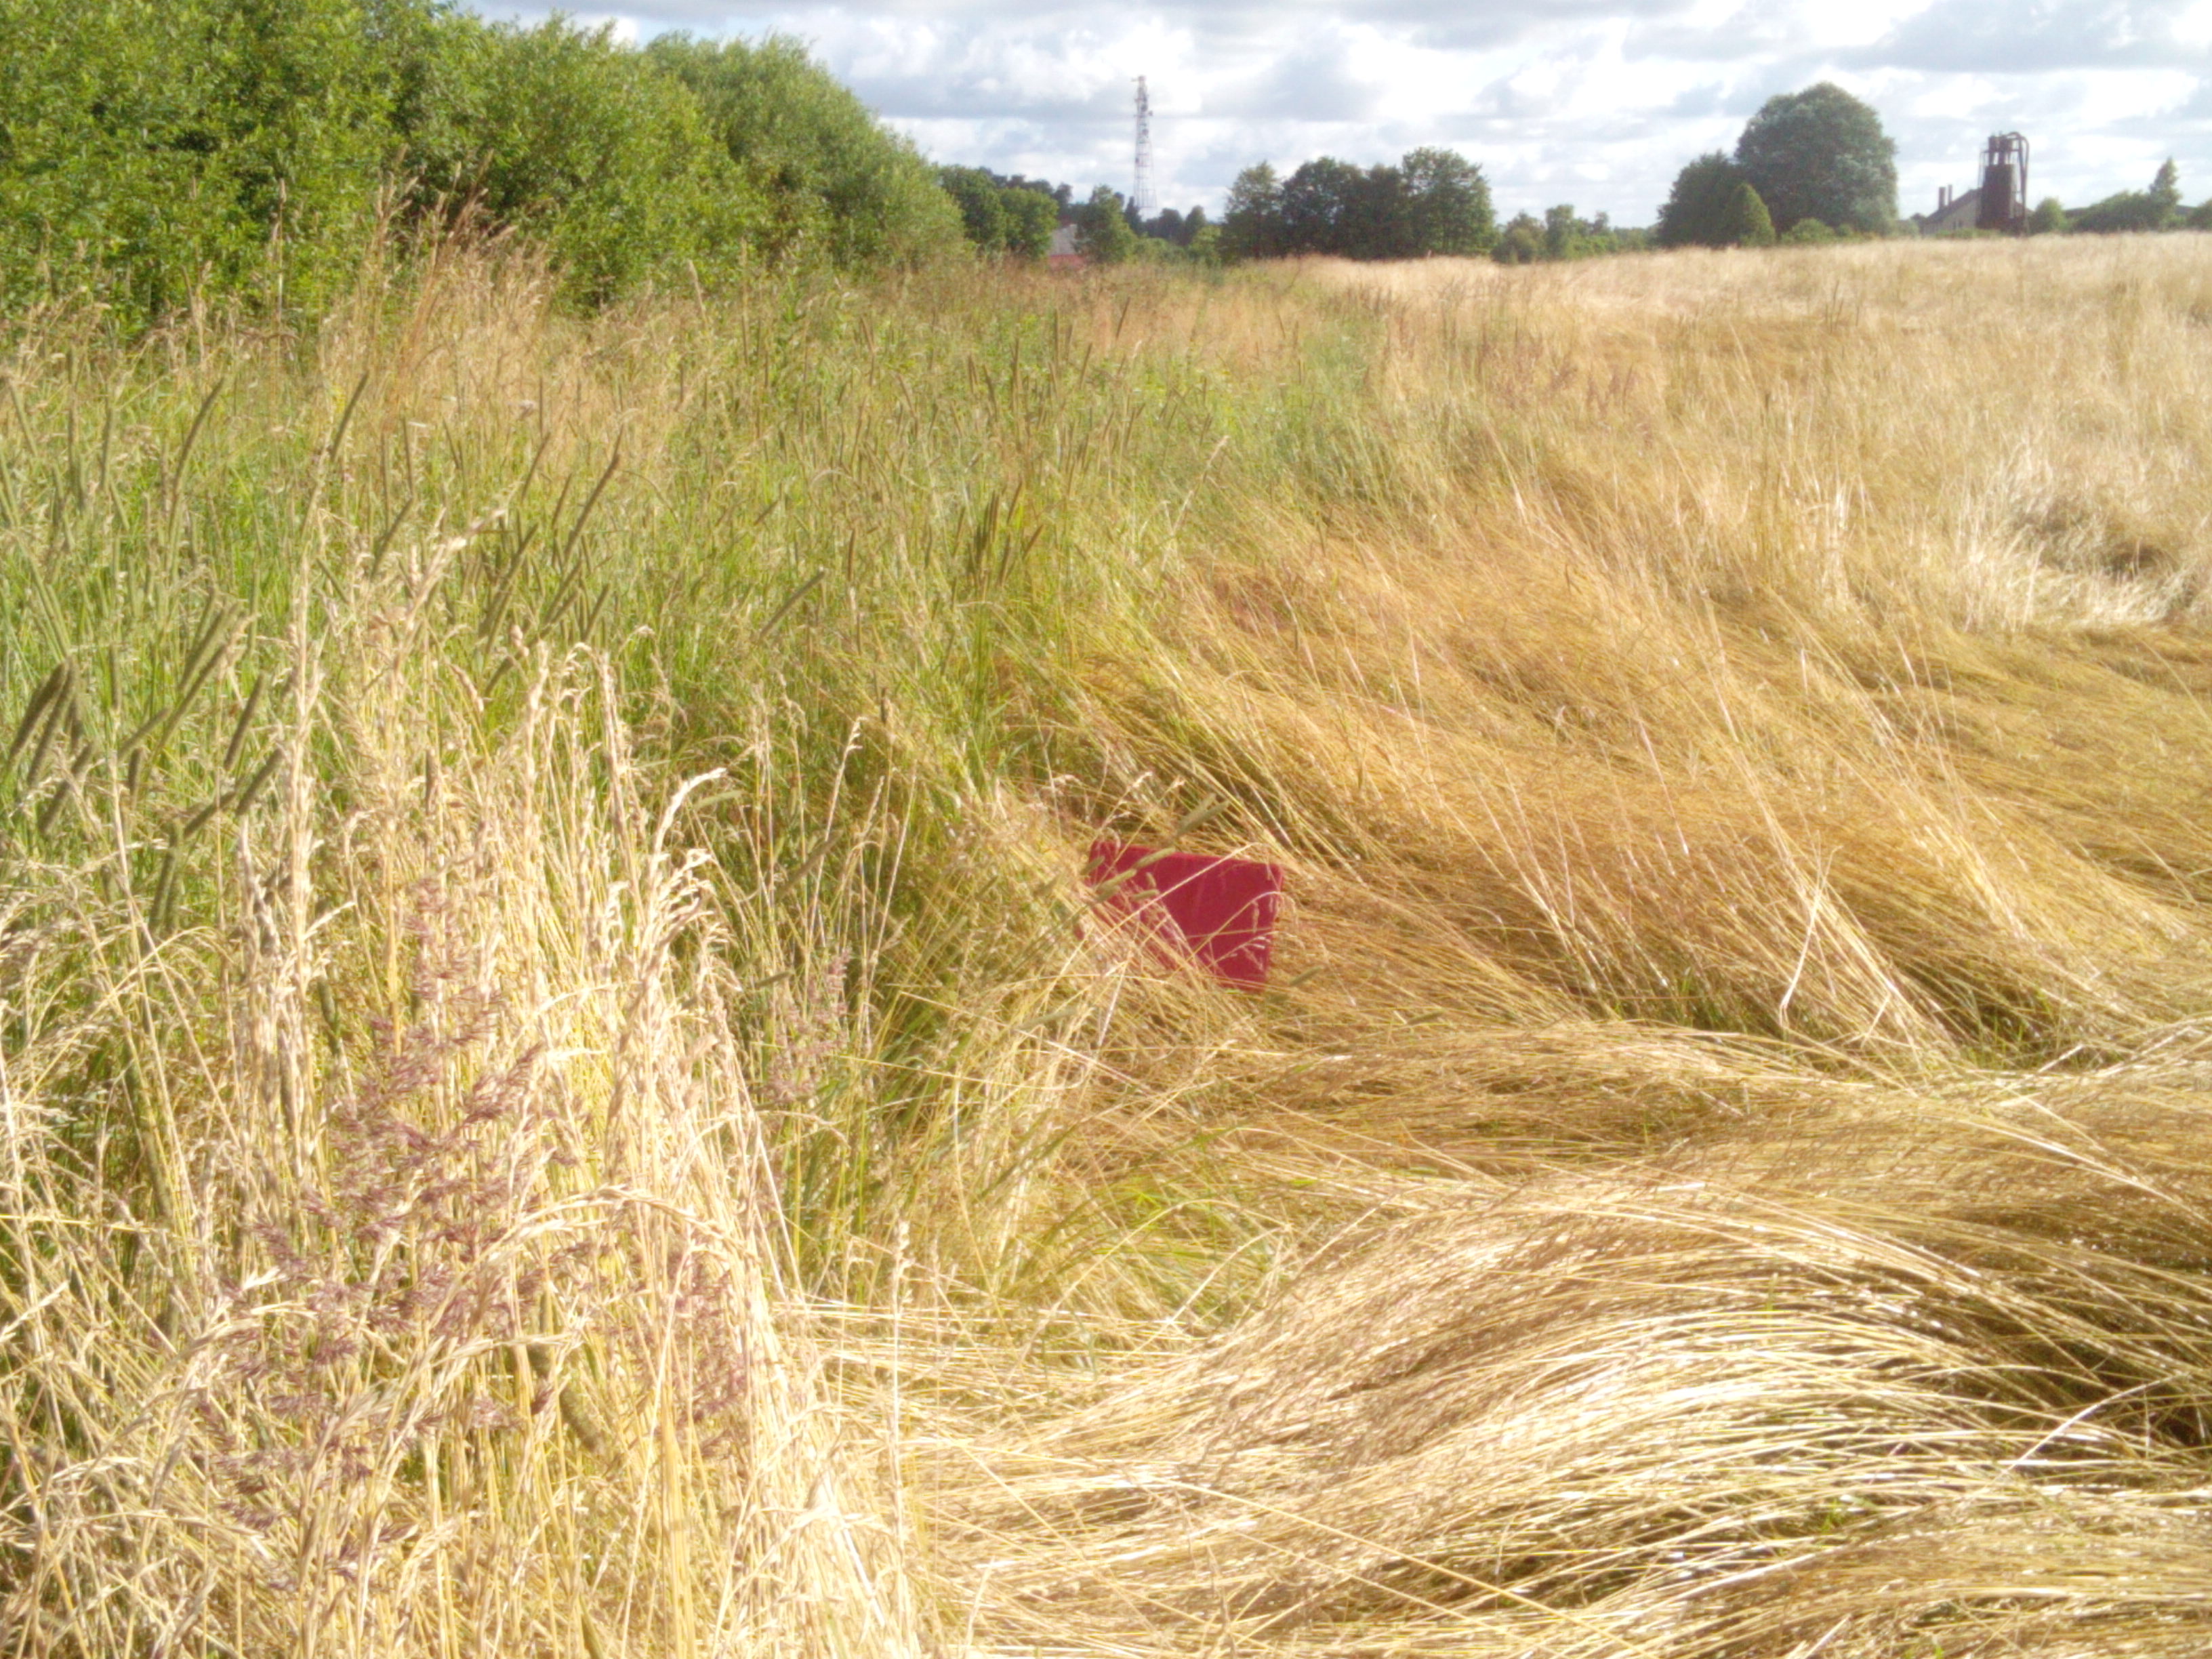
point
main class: Grassland
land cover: Grassland without tree/shrub cover
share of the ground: > 75 %
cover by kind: herbaceous plants 95 %, shrubs 5 %
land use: Agriculture (excluding fallow land and kitchen gardens)
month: July
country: LV
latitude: 56.6848
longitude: 21.3196
